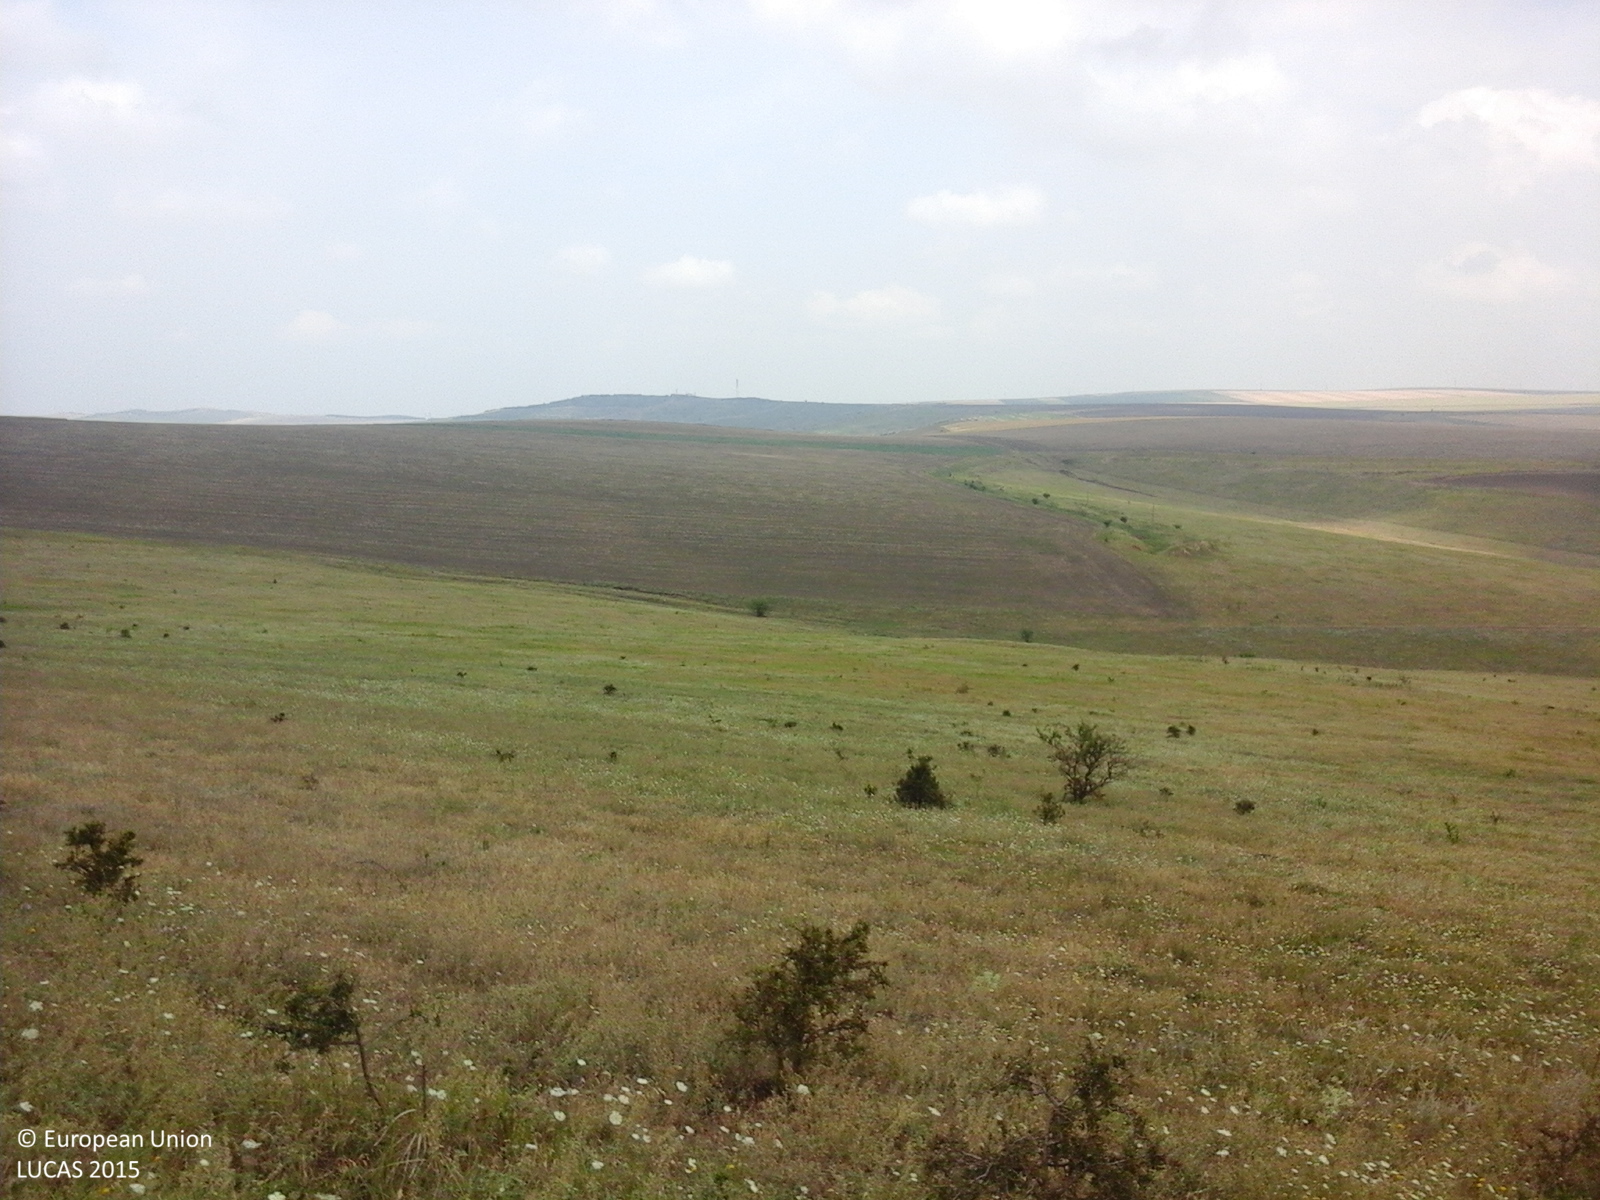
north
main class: Grassland
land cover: Grassland with sparse tree/shrub cover
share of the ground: > 75 %
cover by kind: herbaceous plants 85 %, shrubs 10 %, broadleaved forest trees 5 %
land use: Agriculture (excluding fallow land and kitchen gardens)
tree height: < 5 m
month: July
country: RO
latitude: 45.0757
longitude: 28.7736
